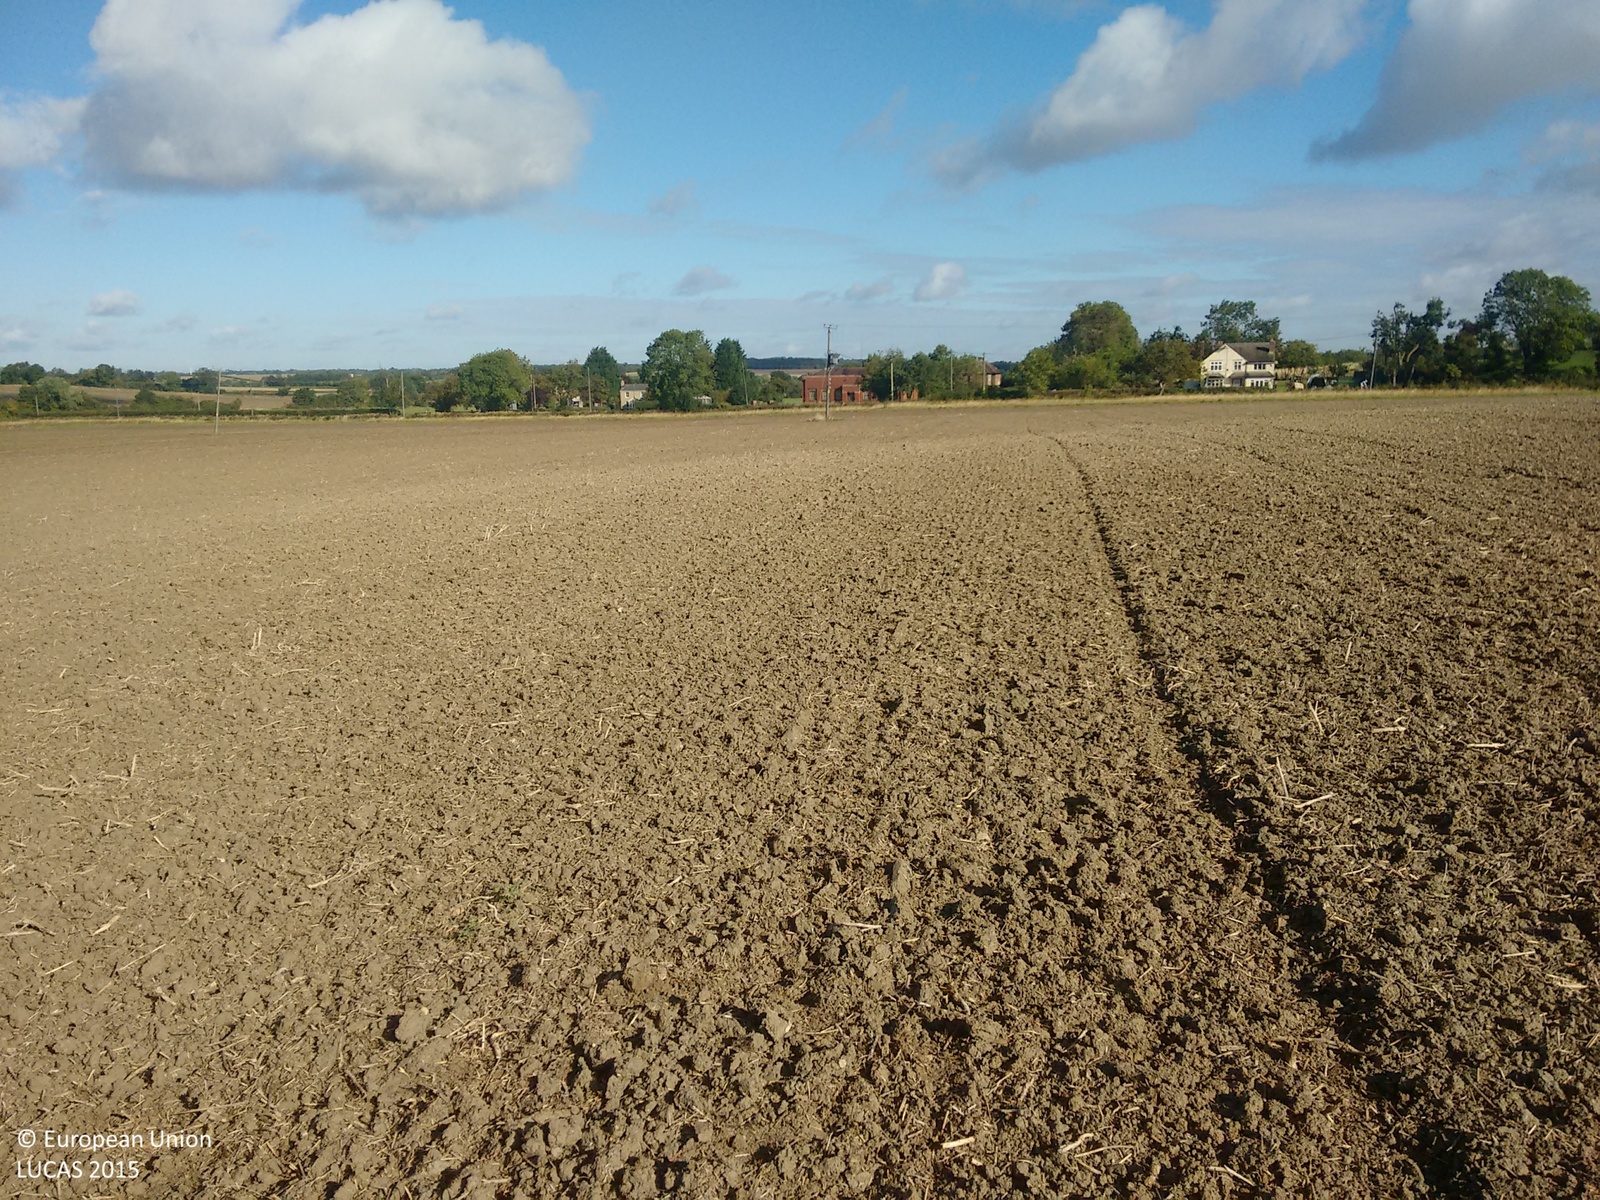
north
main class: Cropland
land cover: Rape and turnip rape
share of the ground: < 10 %
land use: Agriculture (excluding fallow land and kitchen gardens)
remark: Harvested field
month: September
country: GB
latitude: 52.1700
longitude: -0.0193
